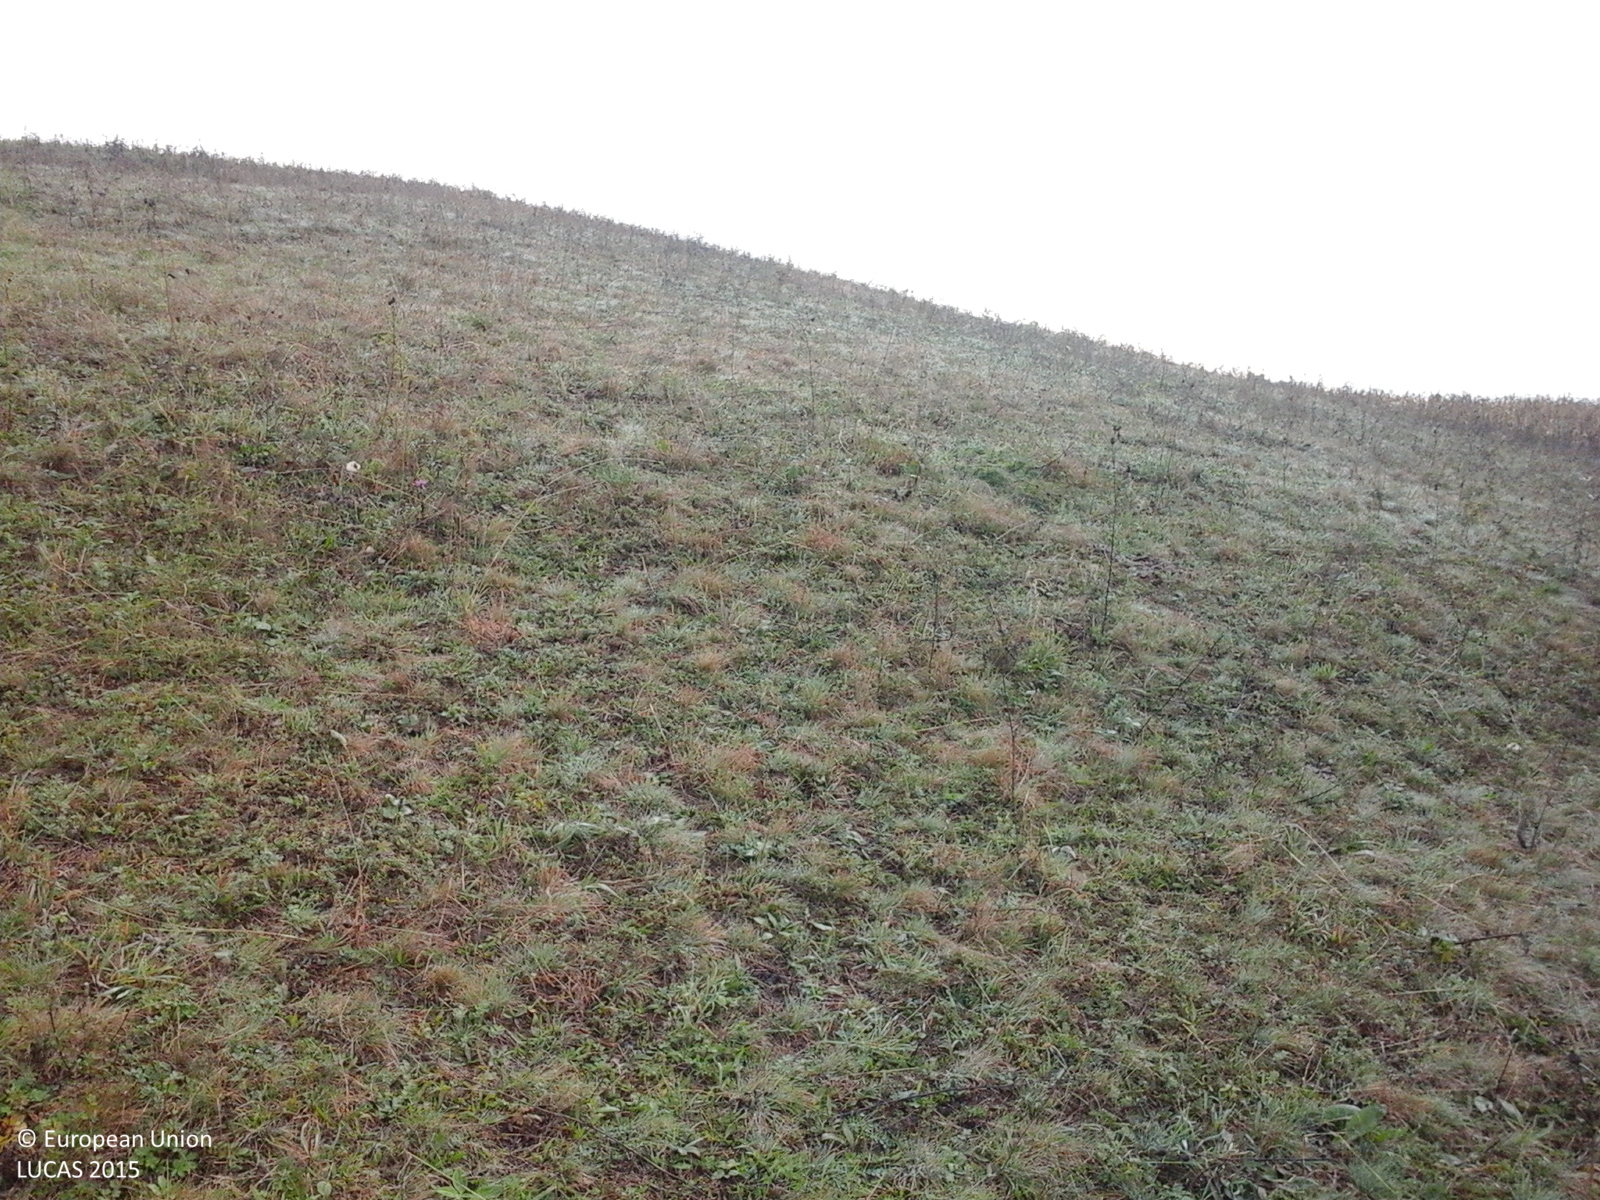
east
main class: Grassland
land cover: Grassland without tree/shrub cover
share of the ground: > 75 %
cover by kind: herbaceous plants 100 %
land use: Agriculture (excluding fallow land and kitchen gardens)
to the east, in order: Grassland without tree/shrub cover; Tracks; Grassland without tree/shrub cover; Maize; Spontaneously vegetated surfaces; Shrubland with sparse tree cover; Grassland without tree/shrub cover
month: October
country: RO
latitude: 45.9890
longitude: 24.6881
